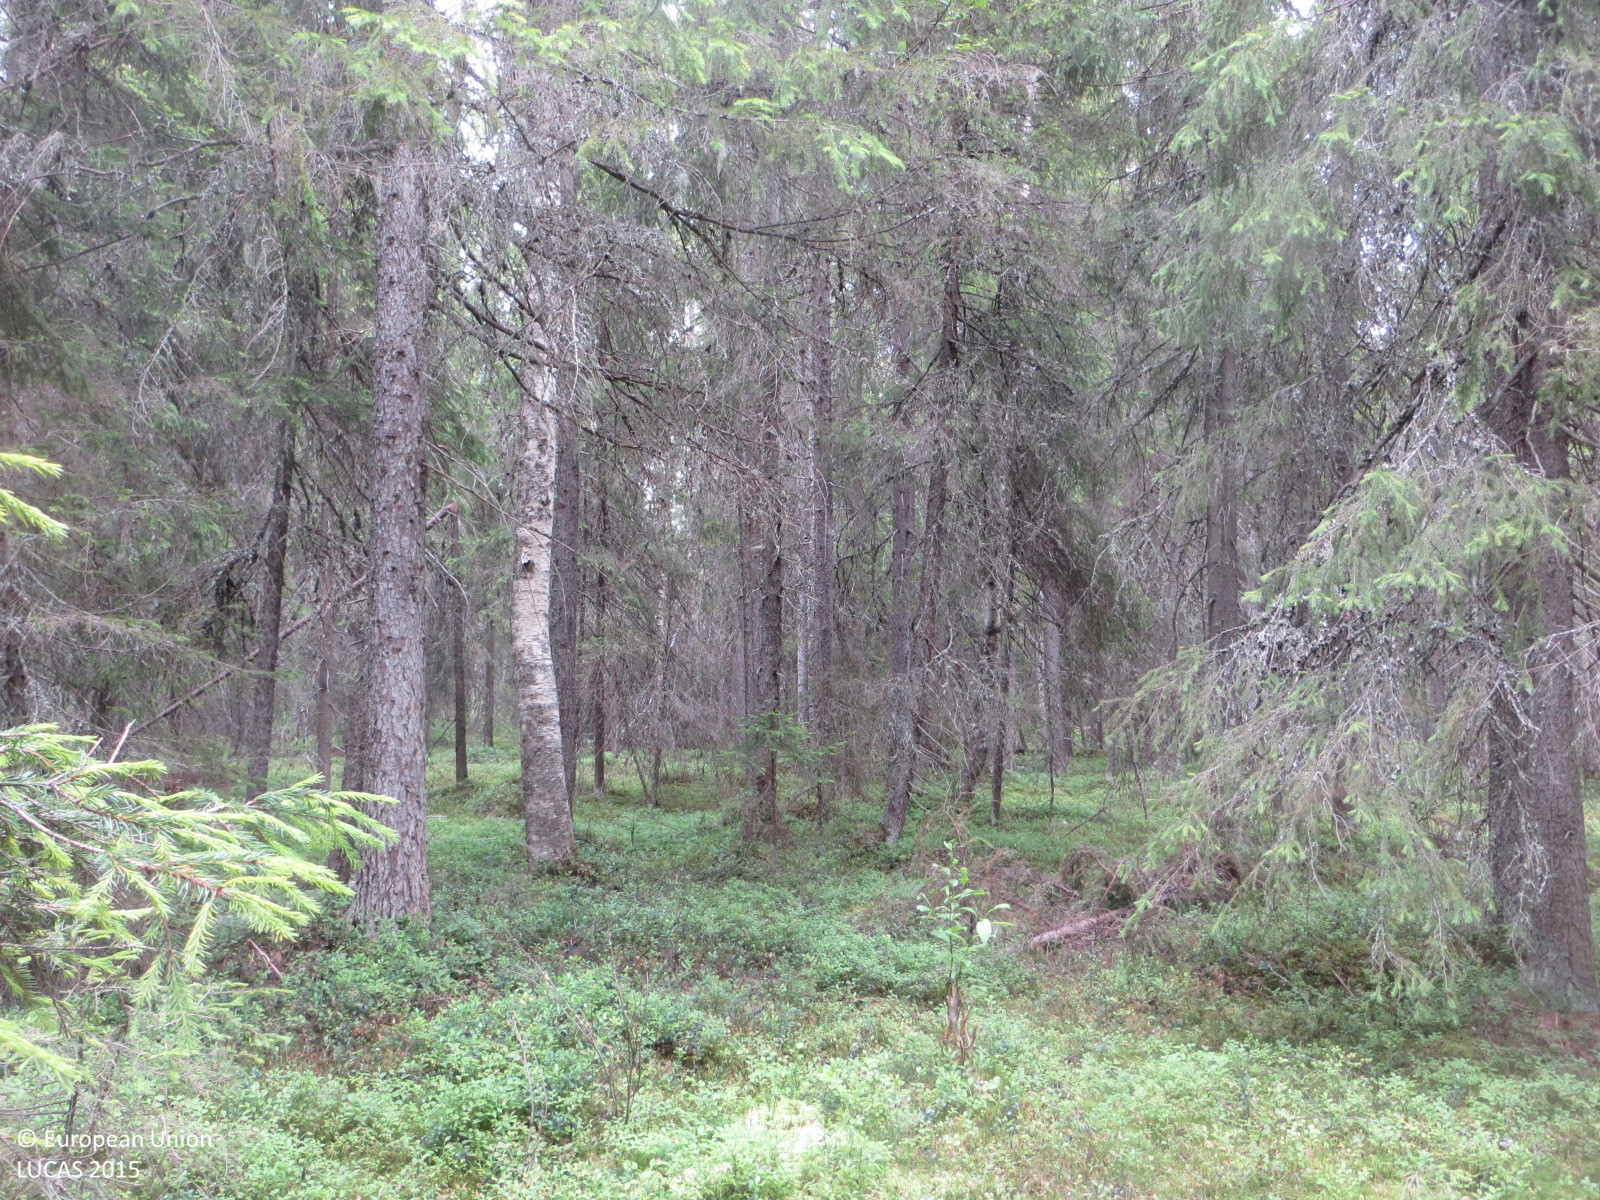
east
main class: Woodland
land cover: Spruce dominated mixed woodland
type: boreal forest
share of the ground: 50 - 75 %
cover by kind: coniferous forest trees 35 %, shrubs 35 %, broadleaved forest trees 30 %
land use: Forestry
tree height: > 5 m
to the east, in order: Spruce dominated mixed woodland; Rivers and streams; Spruce dominated mixed woodland; Tracks; Spruce dominated coniferous woodland
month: July
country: FI
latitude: 65.8110
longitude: 24.5109
